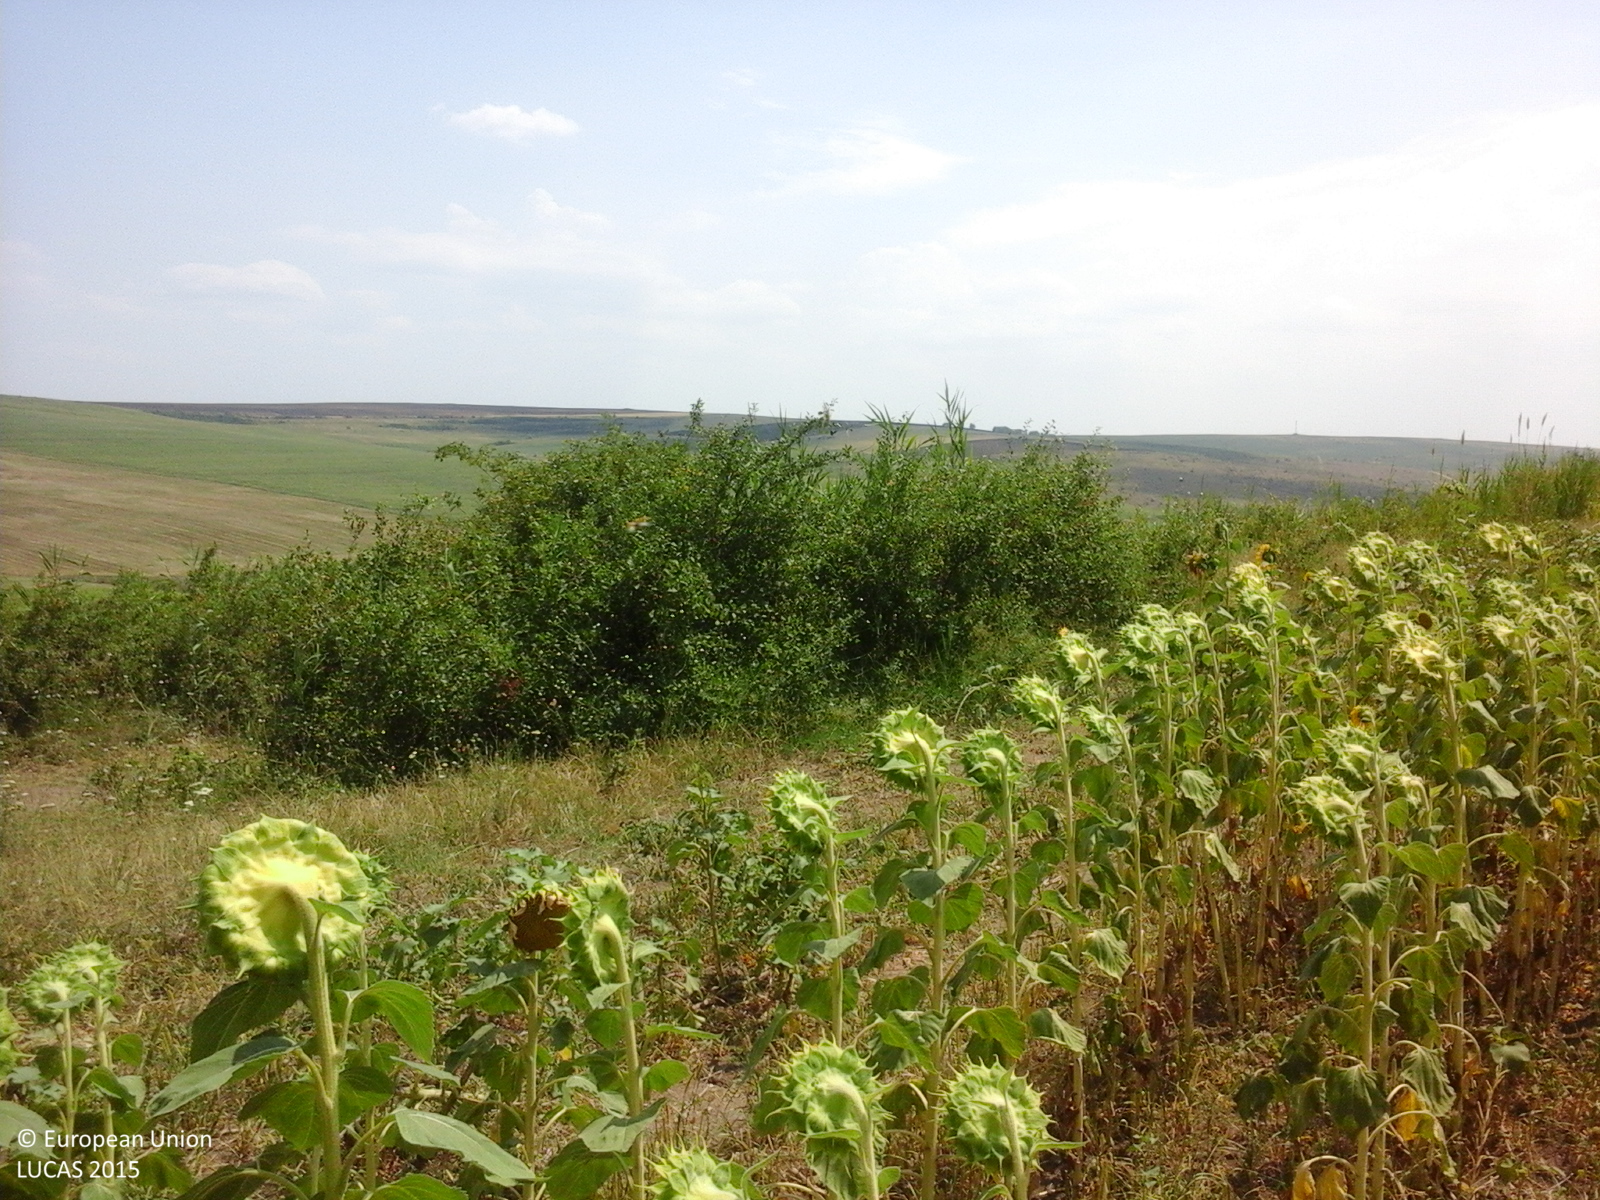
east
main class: Cropland
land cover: Sunflower
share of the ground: > 75 %
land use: Agriculture (excluding fallow land and kitchen gardens)
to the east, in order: Sunflower; Grassland without tree/shrub cover; Maize; Common wheat
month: July
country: RO
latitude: 46.0745
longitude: 28.0316
